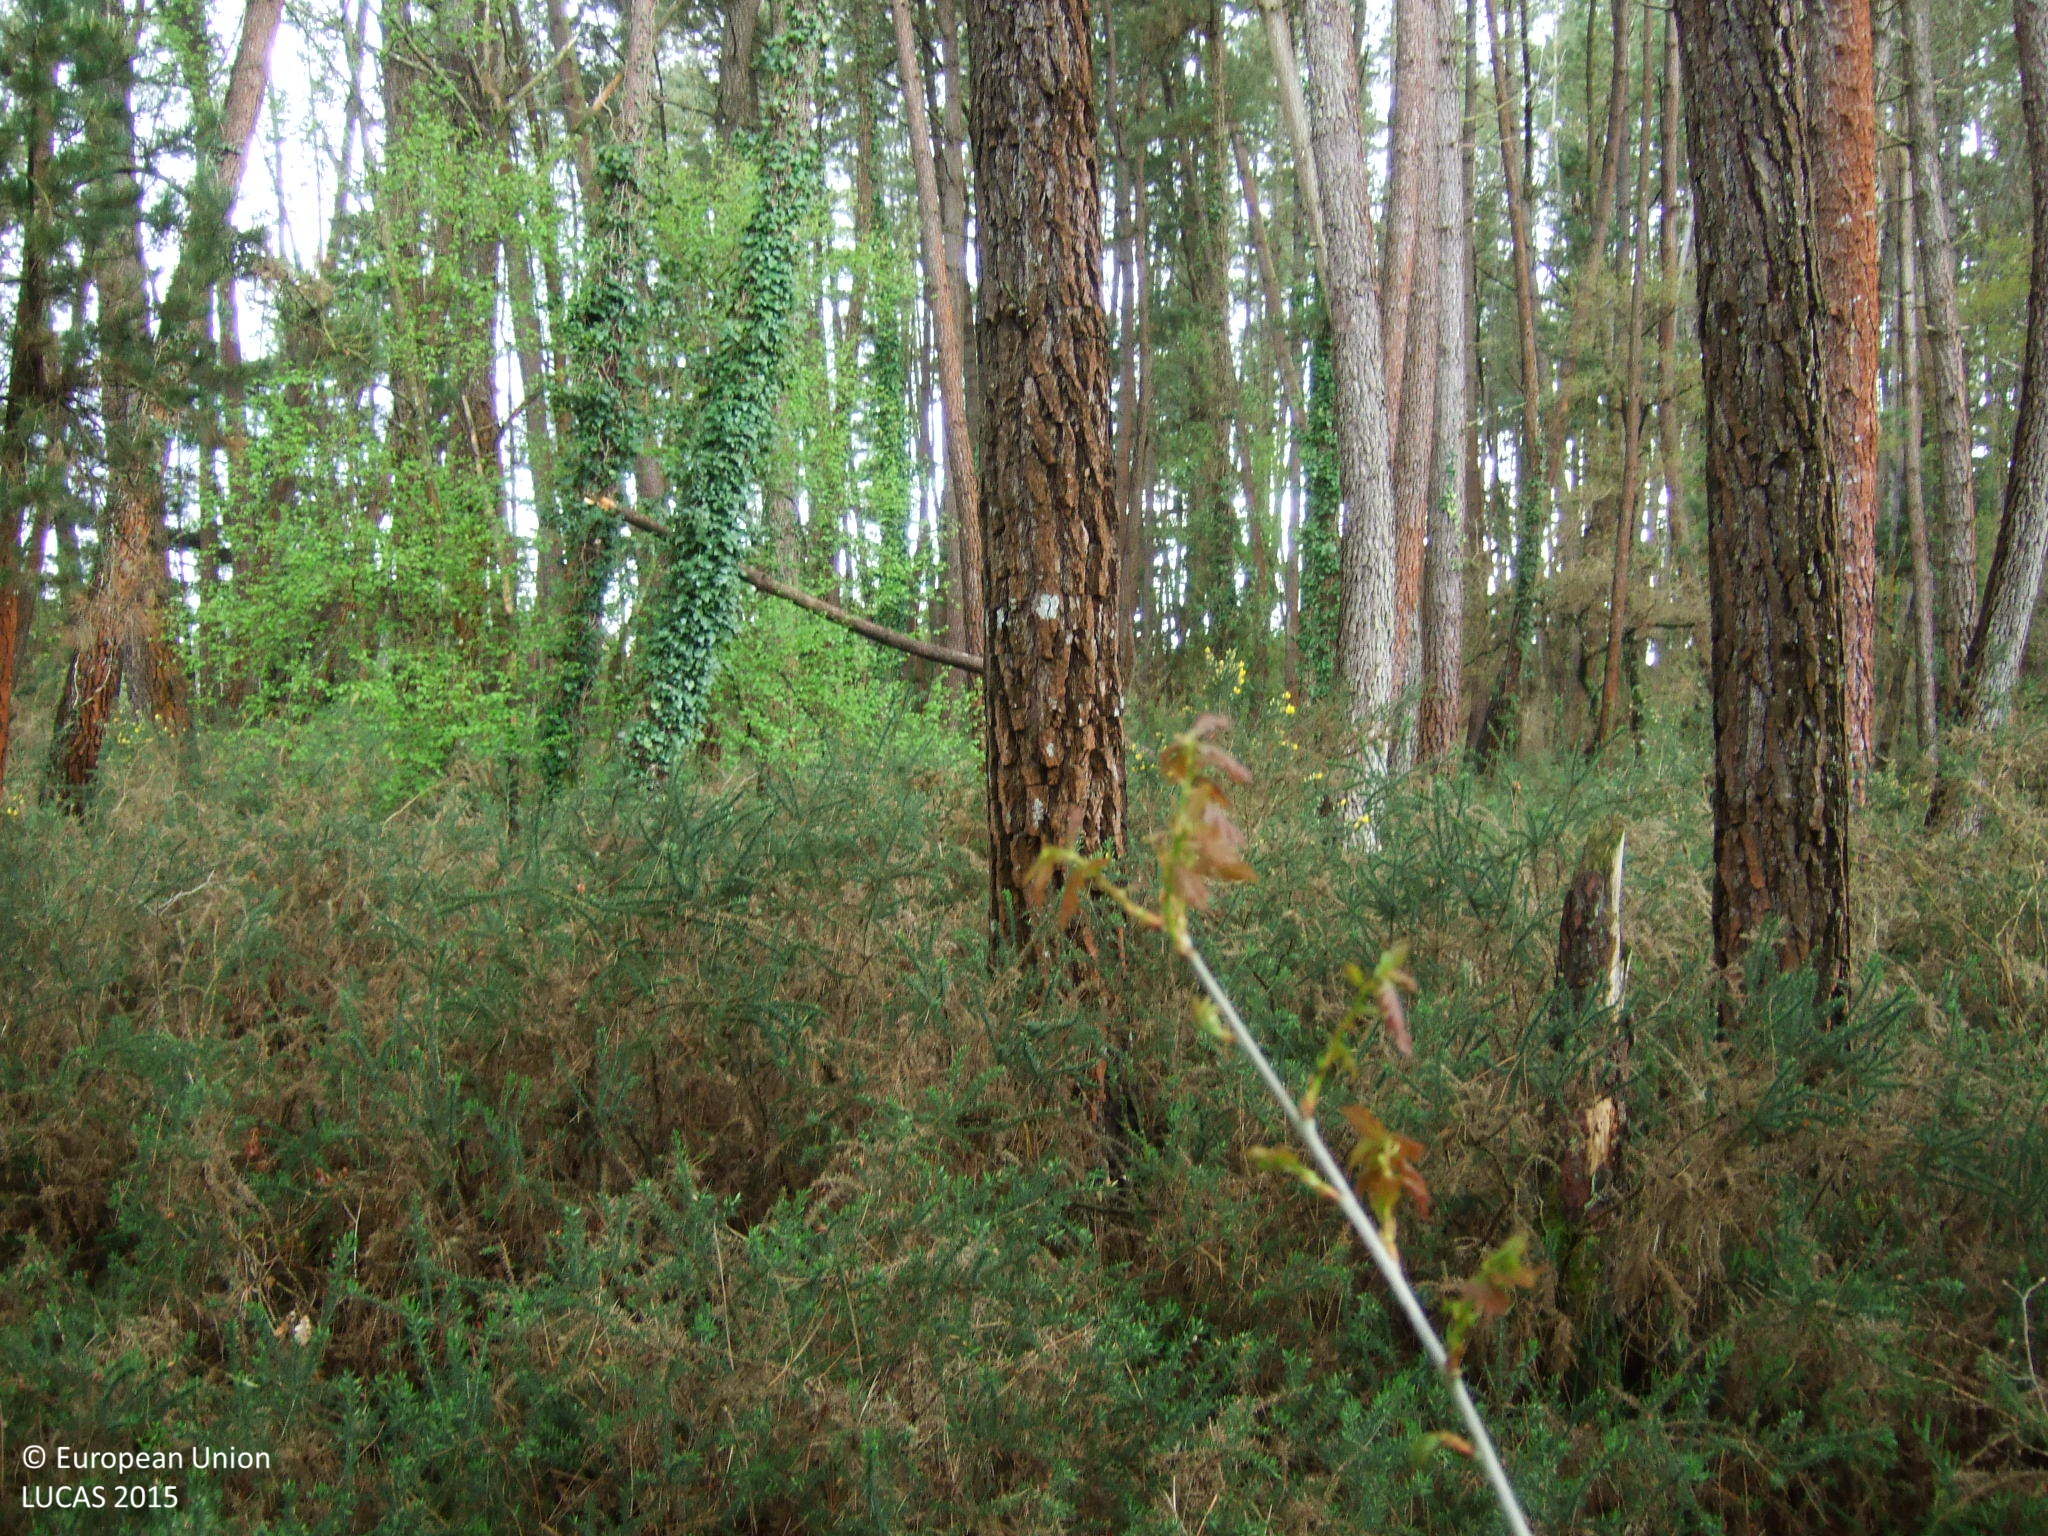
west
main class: Woodland
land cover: Pine dominated coniferous woodland
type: exotic forest
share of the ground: 25 - 50 %
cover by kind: coniferous forest trees 50 %, shrubs 50 %
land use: Forestry
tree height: > 5 m
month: April
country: ES
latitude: 42.9381
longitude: -7.4124
